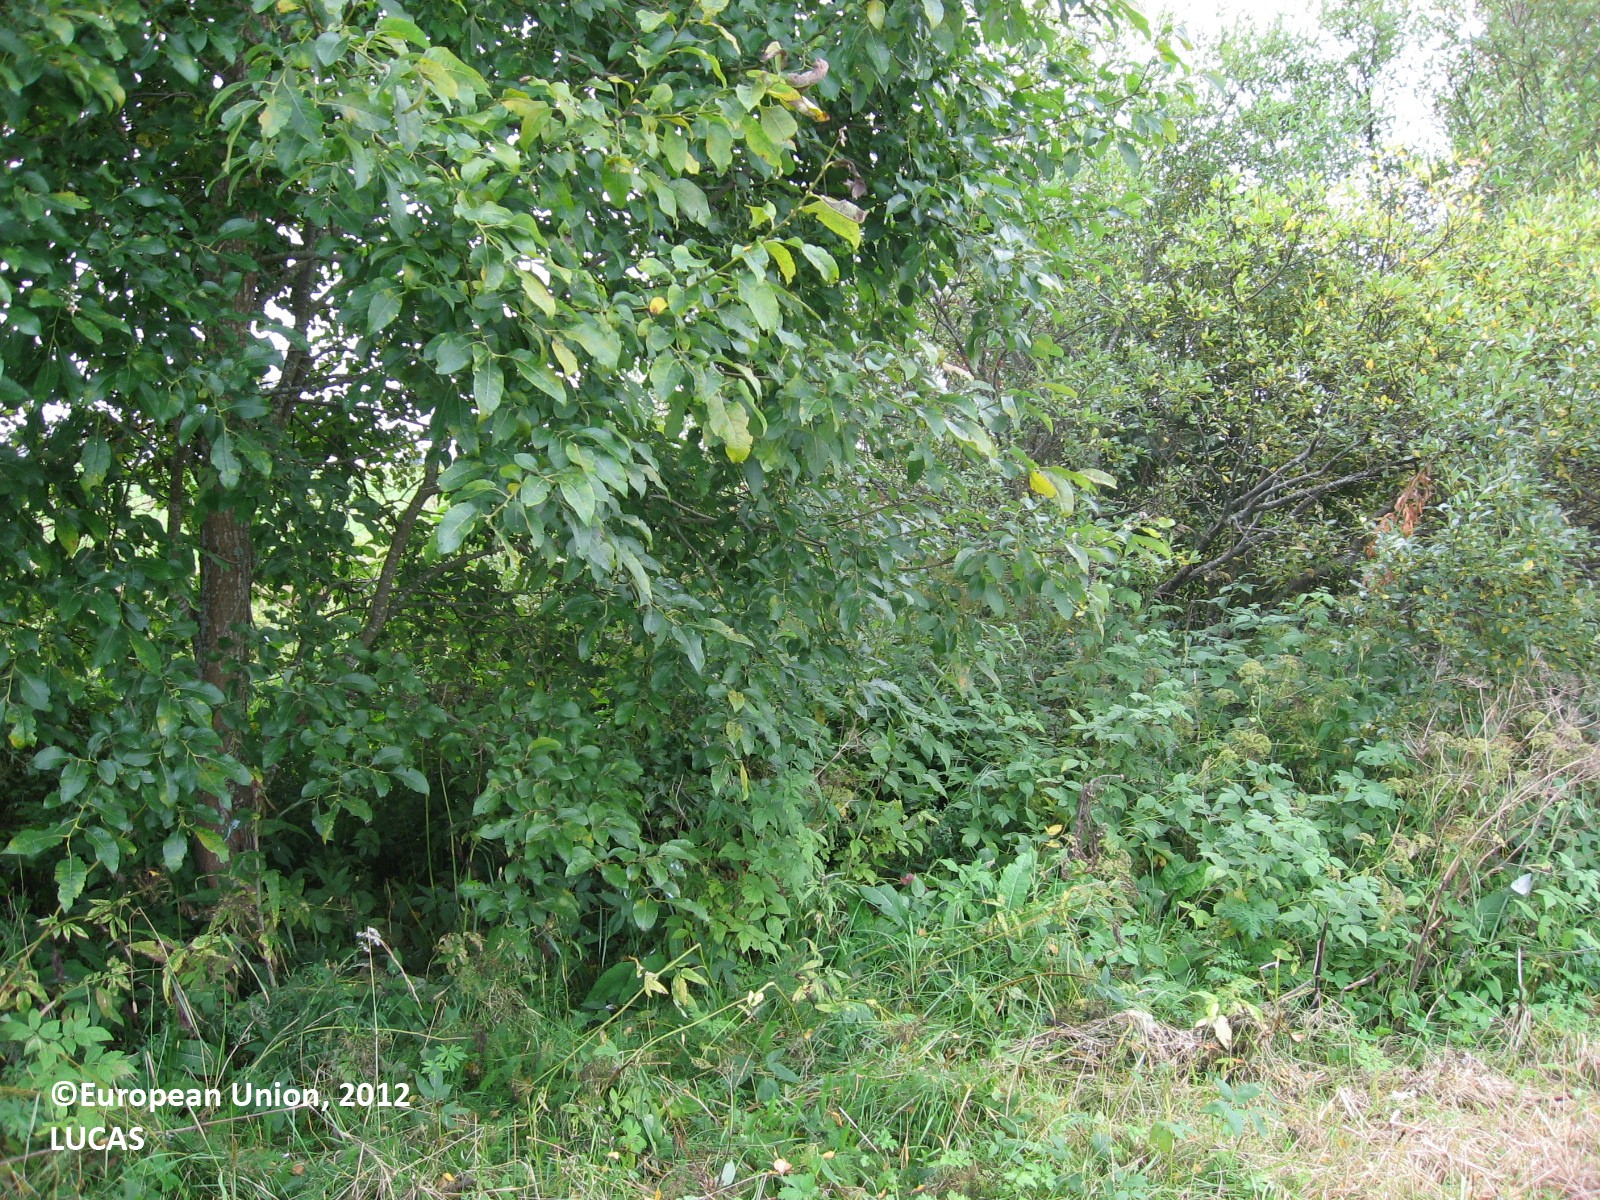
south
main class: Cropland
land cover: Temporary grasslands
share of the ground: > 75 %
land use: Agriculture (excluding fallow land and kitchen gardens)
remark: Harvested field
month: August
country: FI
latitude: 60.9557
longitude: 25.3181
